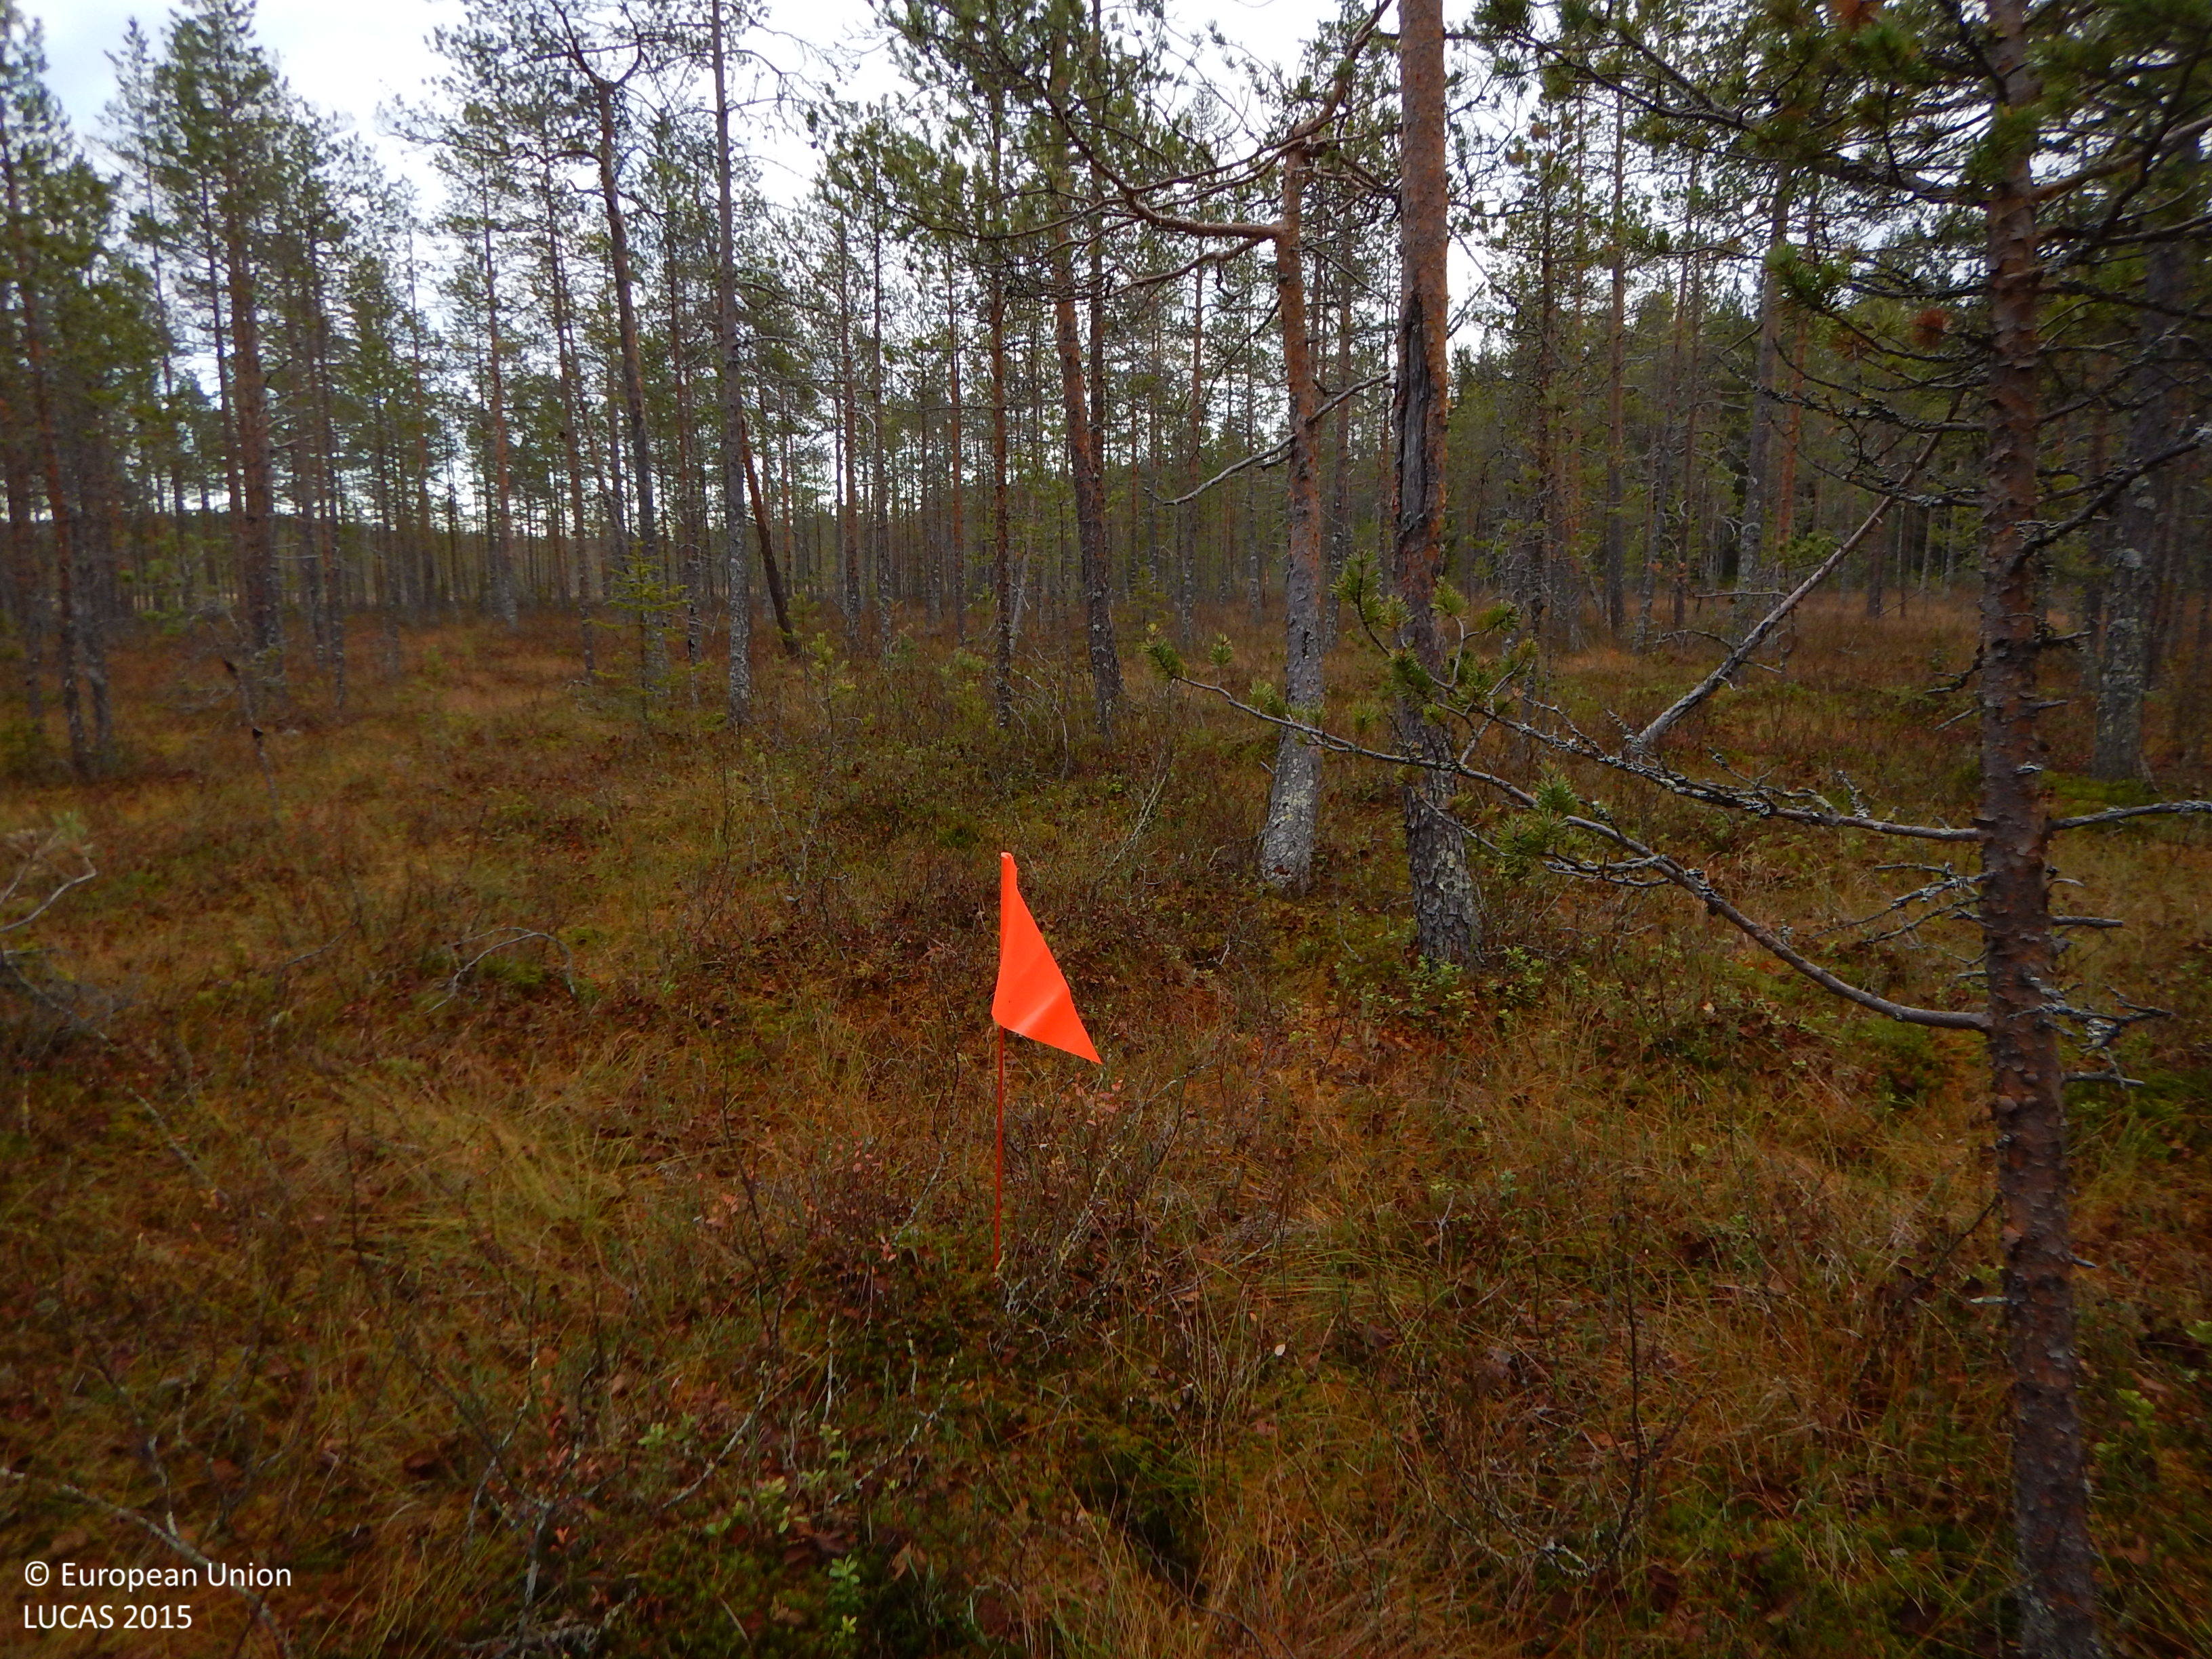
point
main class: Woodland
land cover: Pine dominated coniferous woodland
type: mire and swamp forests
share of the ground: 25 - 50 %
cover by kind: coniferous forest trees 40 %, lichens and mosses 30 %, shrubs 20 %, herbaceous plants 10 %
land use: Semi-natural and natural areas not in use
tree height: > 5 m
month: October
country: SE
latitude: 65.1010
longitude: 21.1515
